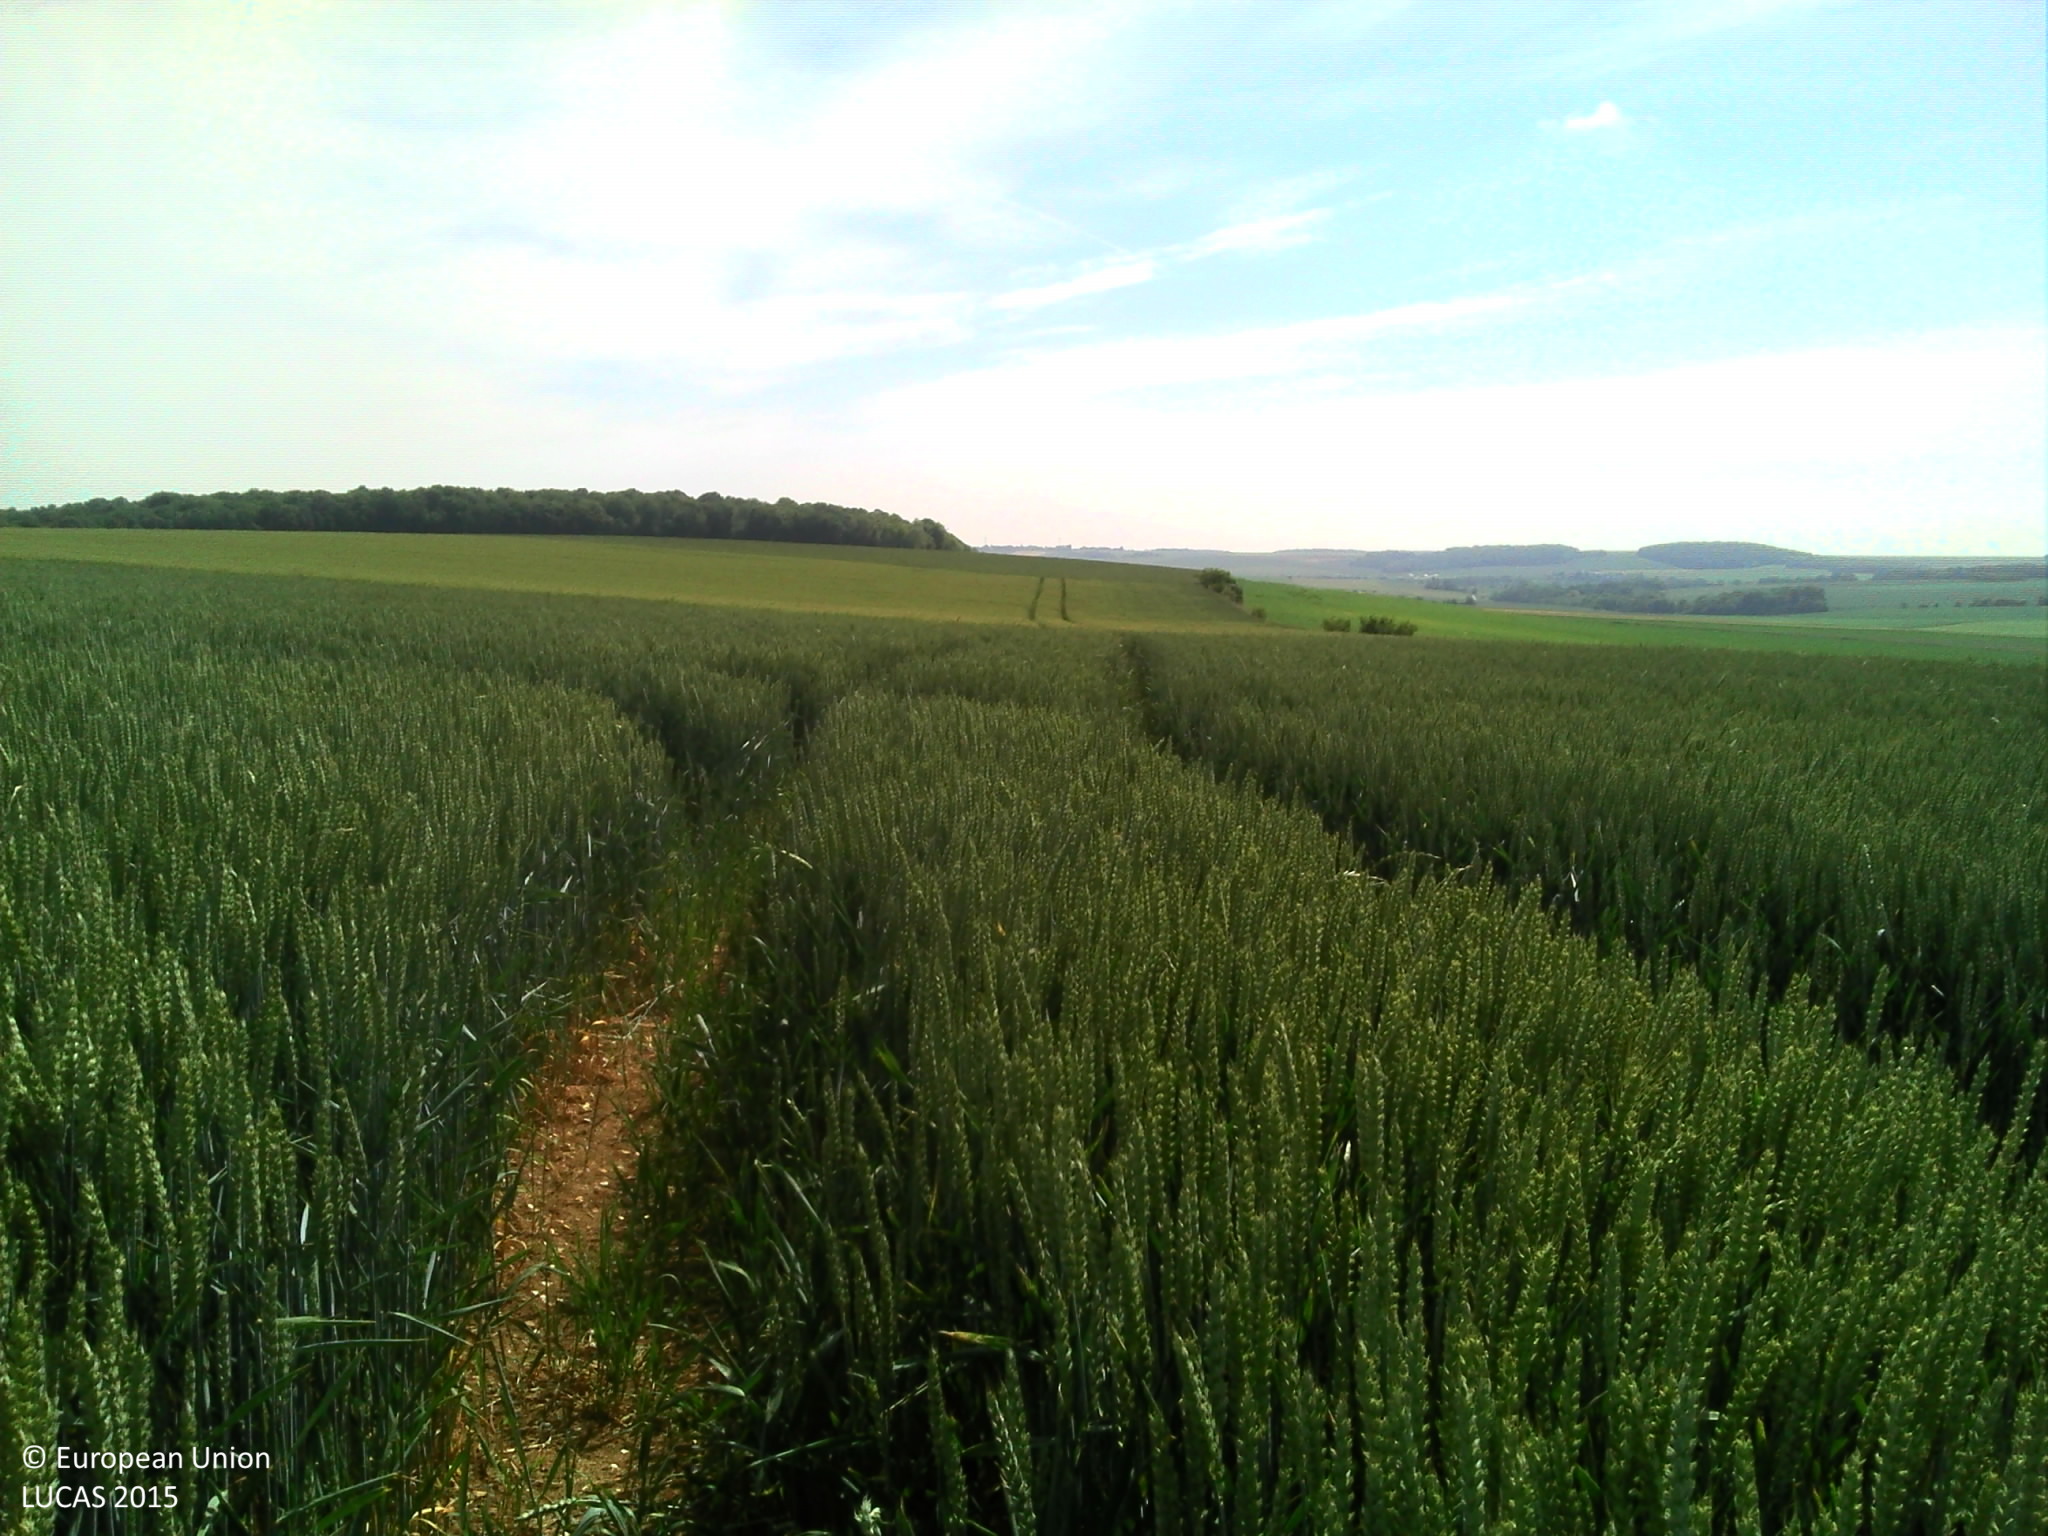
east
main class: Cropland
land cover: Common wheat
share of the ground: > 75 %
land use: Agriculture (excluding fallow land and kitchen gardens)
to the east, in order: Common wheat; Grass margins; Dry pulses; Grass margins
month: June
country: FR
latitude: 49.7062
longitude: 2.2907
